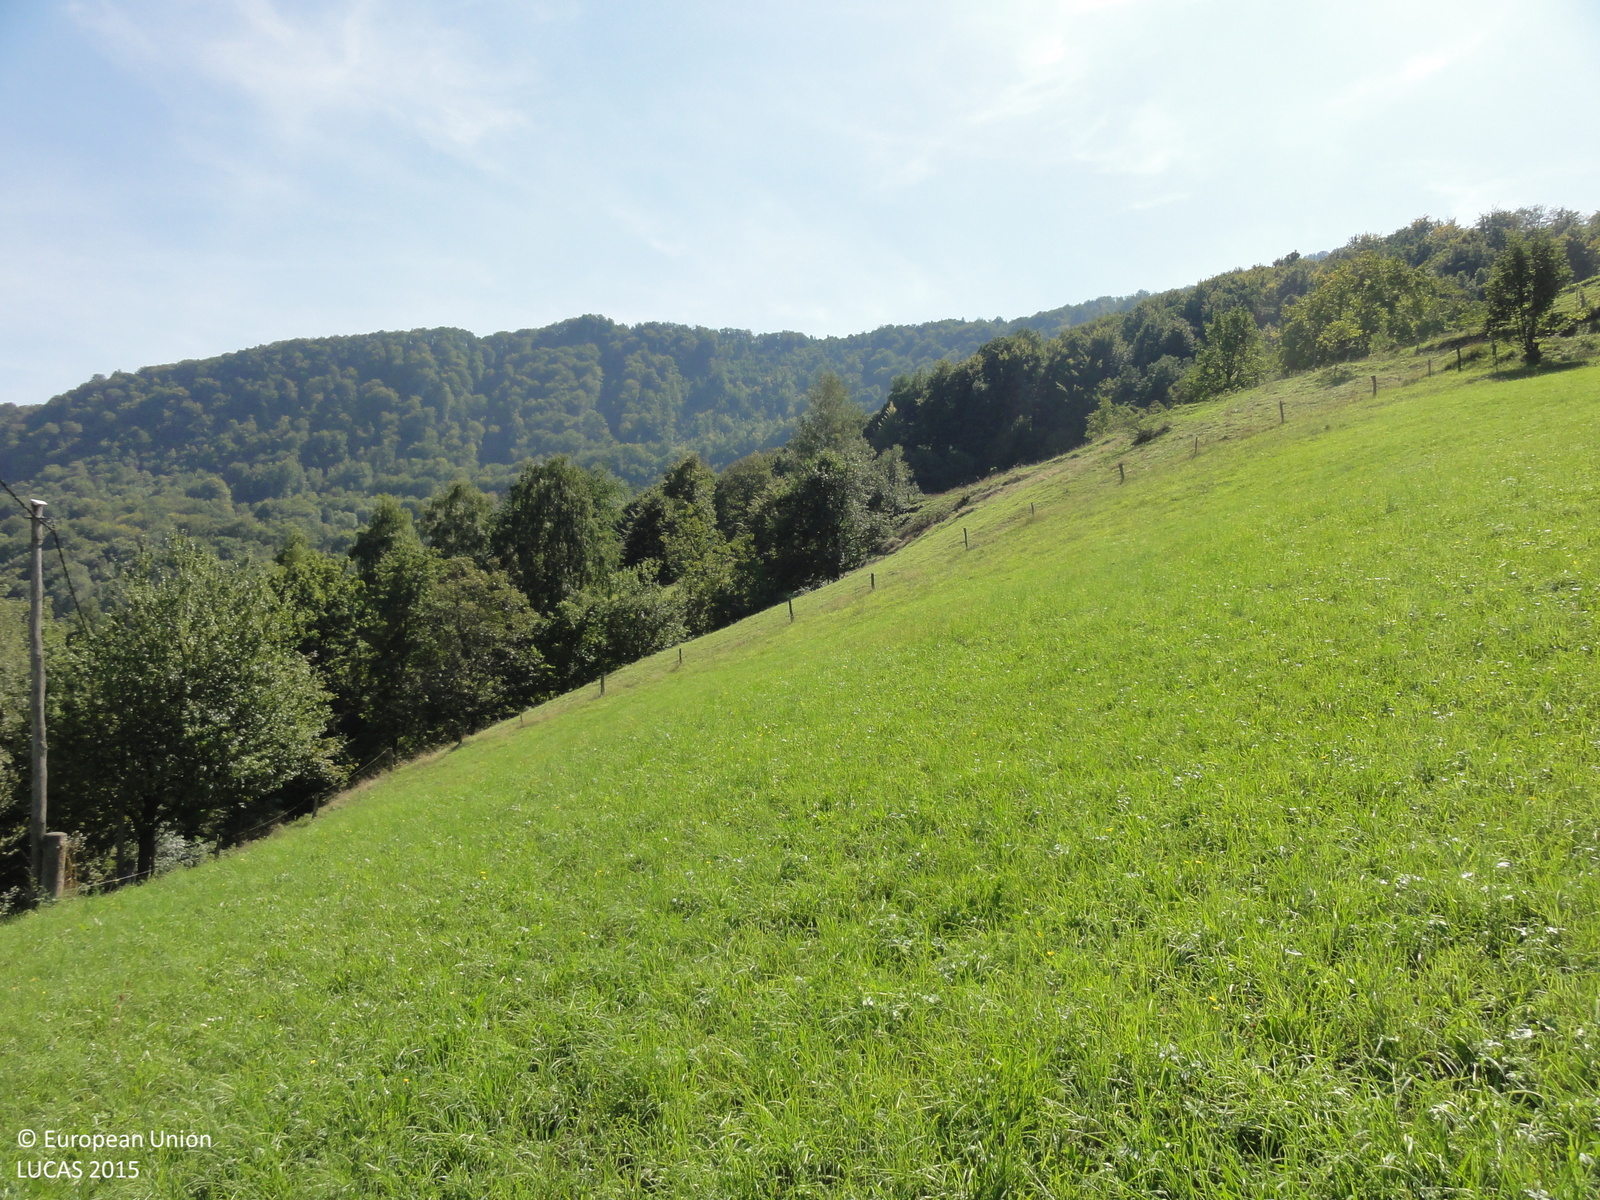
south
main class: Grassland
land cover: Grassland without tree/shrub cover
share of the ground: > 75 %
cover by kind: herbaceous plants 100 %
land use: Agriculture (excluding fallow land and kitchen gardens)
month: August
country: SI
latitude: 46.1017
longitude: 15.1328
